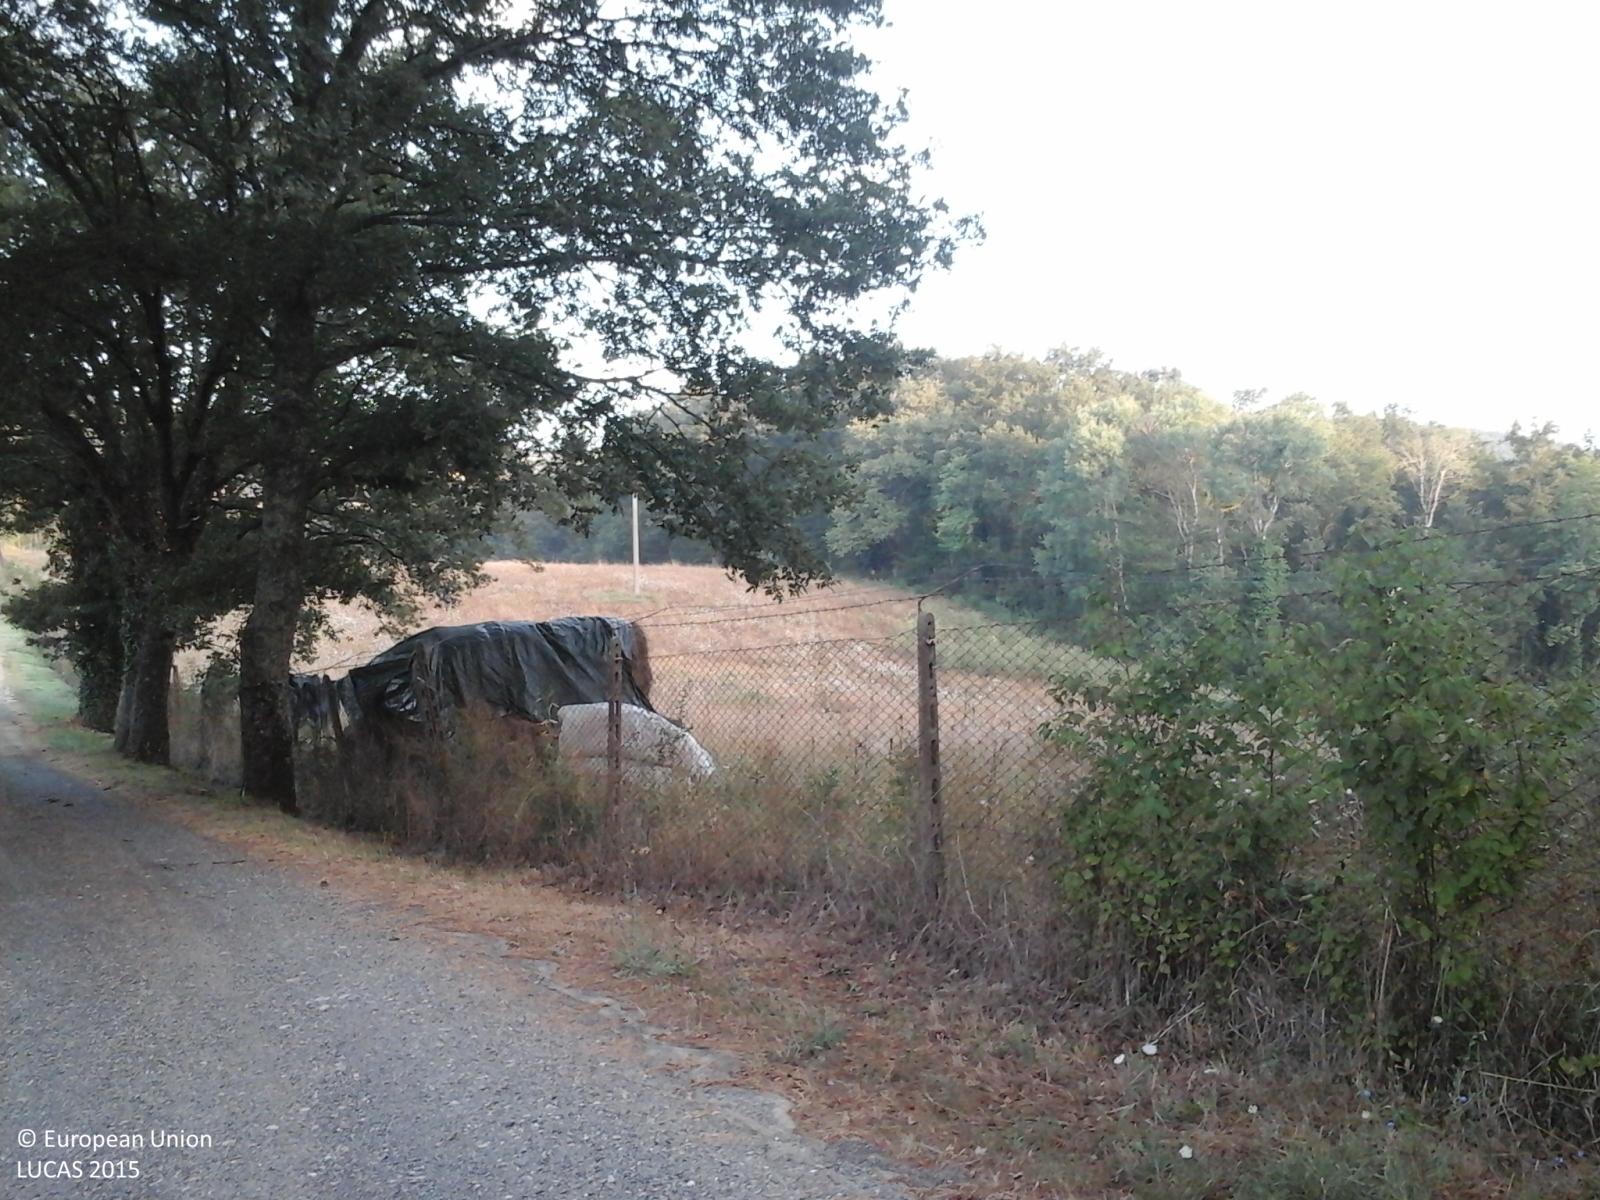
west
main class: Woodland
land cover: Broadleaved woodland
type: thermophilous deciduous forest
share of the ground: > 75 %
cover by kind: broadleaved forest trees 100 %
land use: Forestry
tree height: > 5 m
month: July
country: IT
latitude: 43.4438
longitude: 10.9734
